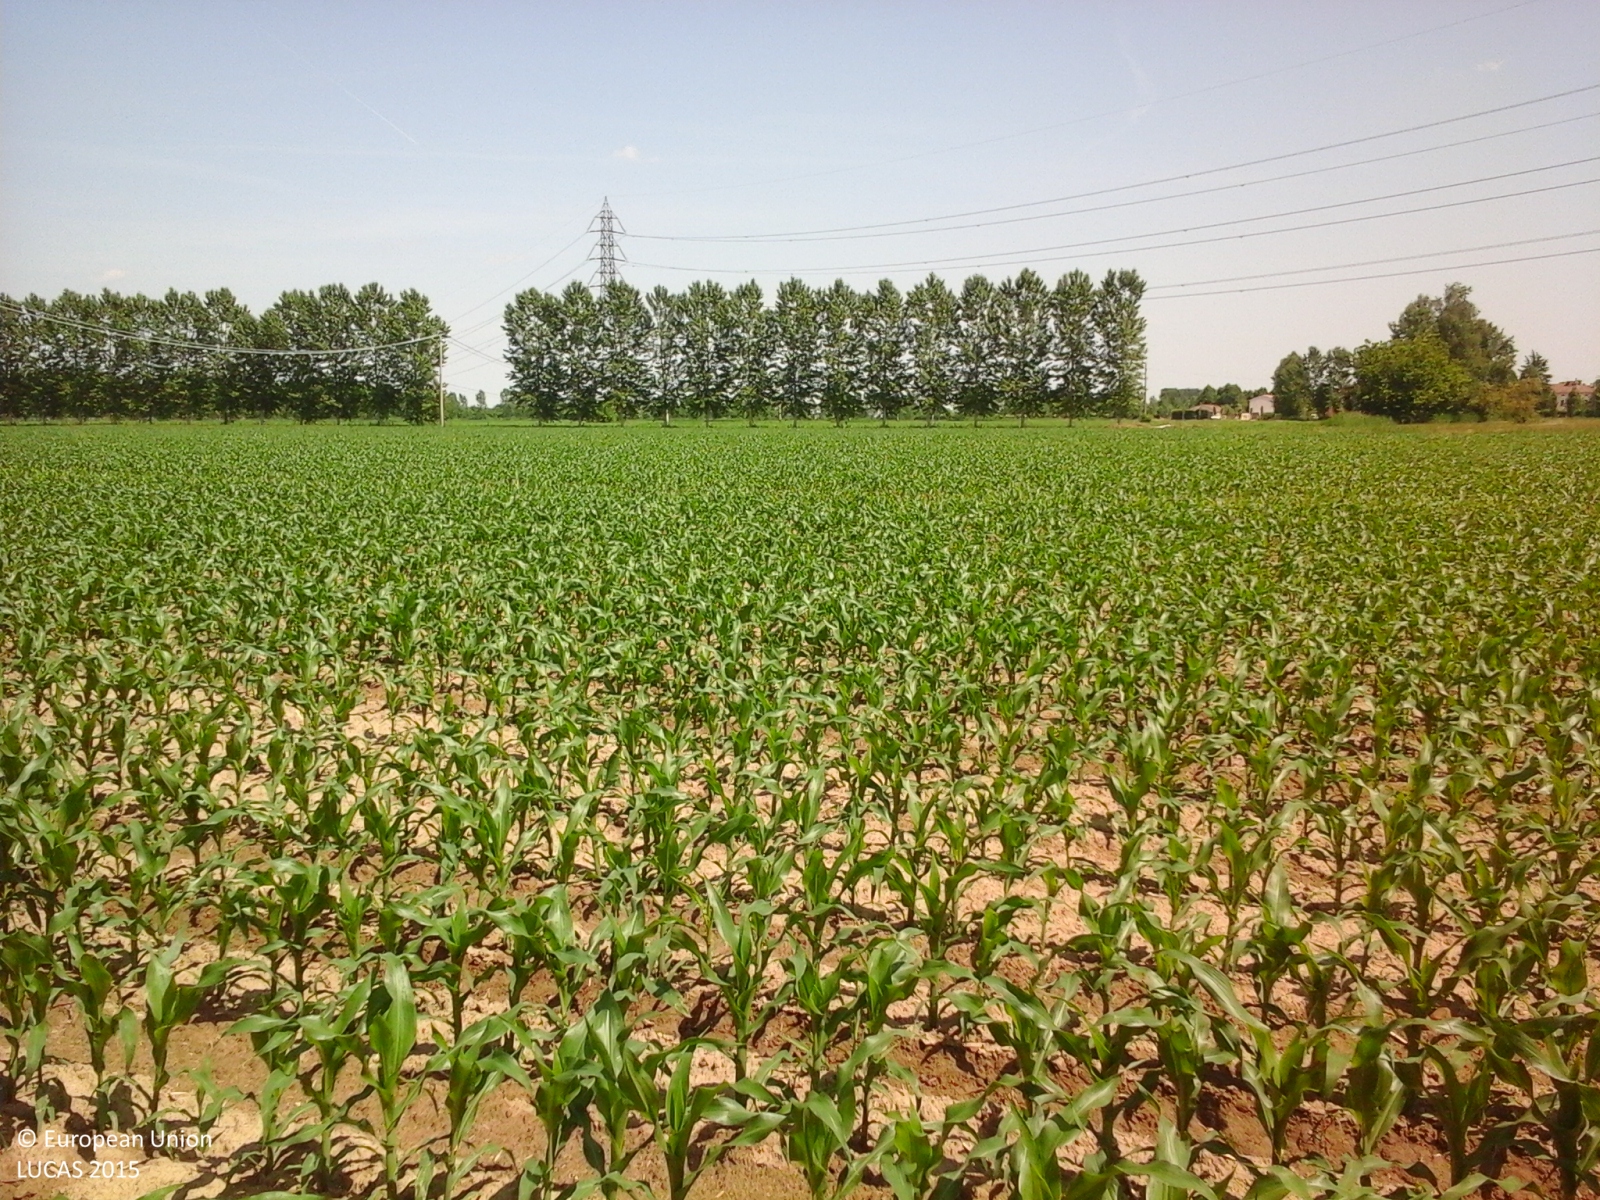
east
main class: Cropland
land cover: Maize
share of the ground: 25 - 50 %
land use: Agriculture (excluding fallow land and kitchen gardens)
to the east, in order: Maize; Ditches and canals; Maize; Ditches and canals; Grass margins; Tracks; Grass margins; Ditches and canals; Managed hedges; Grass margins; Maize; Electric lines; Maize
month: May
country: IT
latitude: 45.1761
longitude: 10.9018
